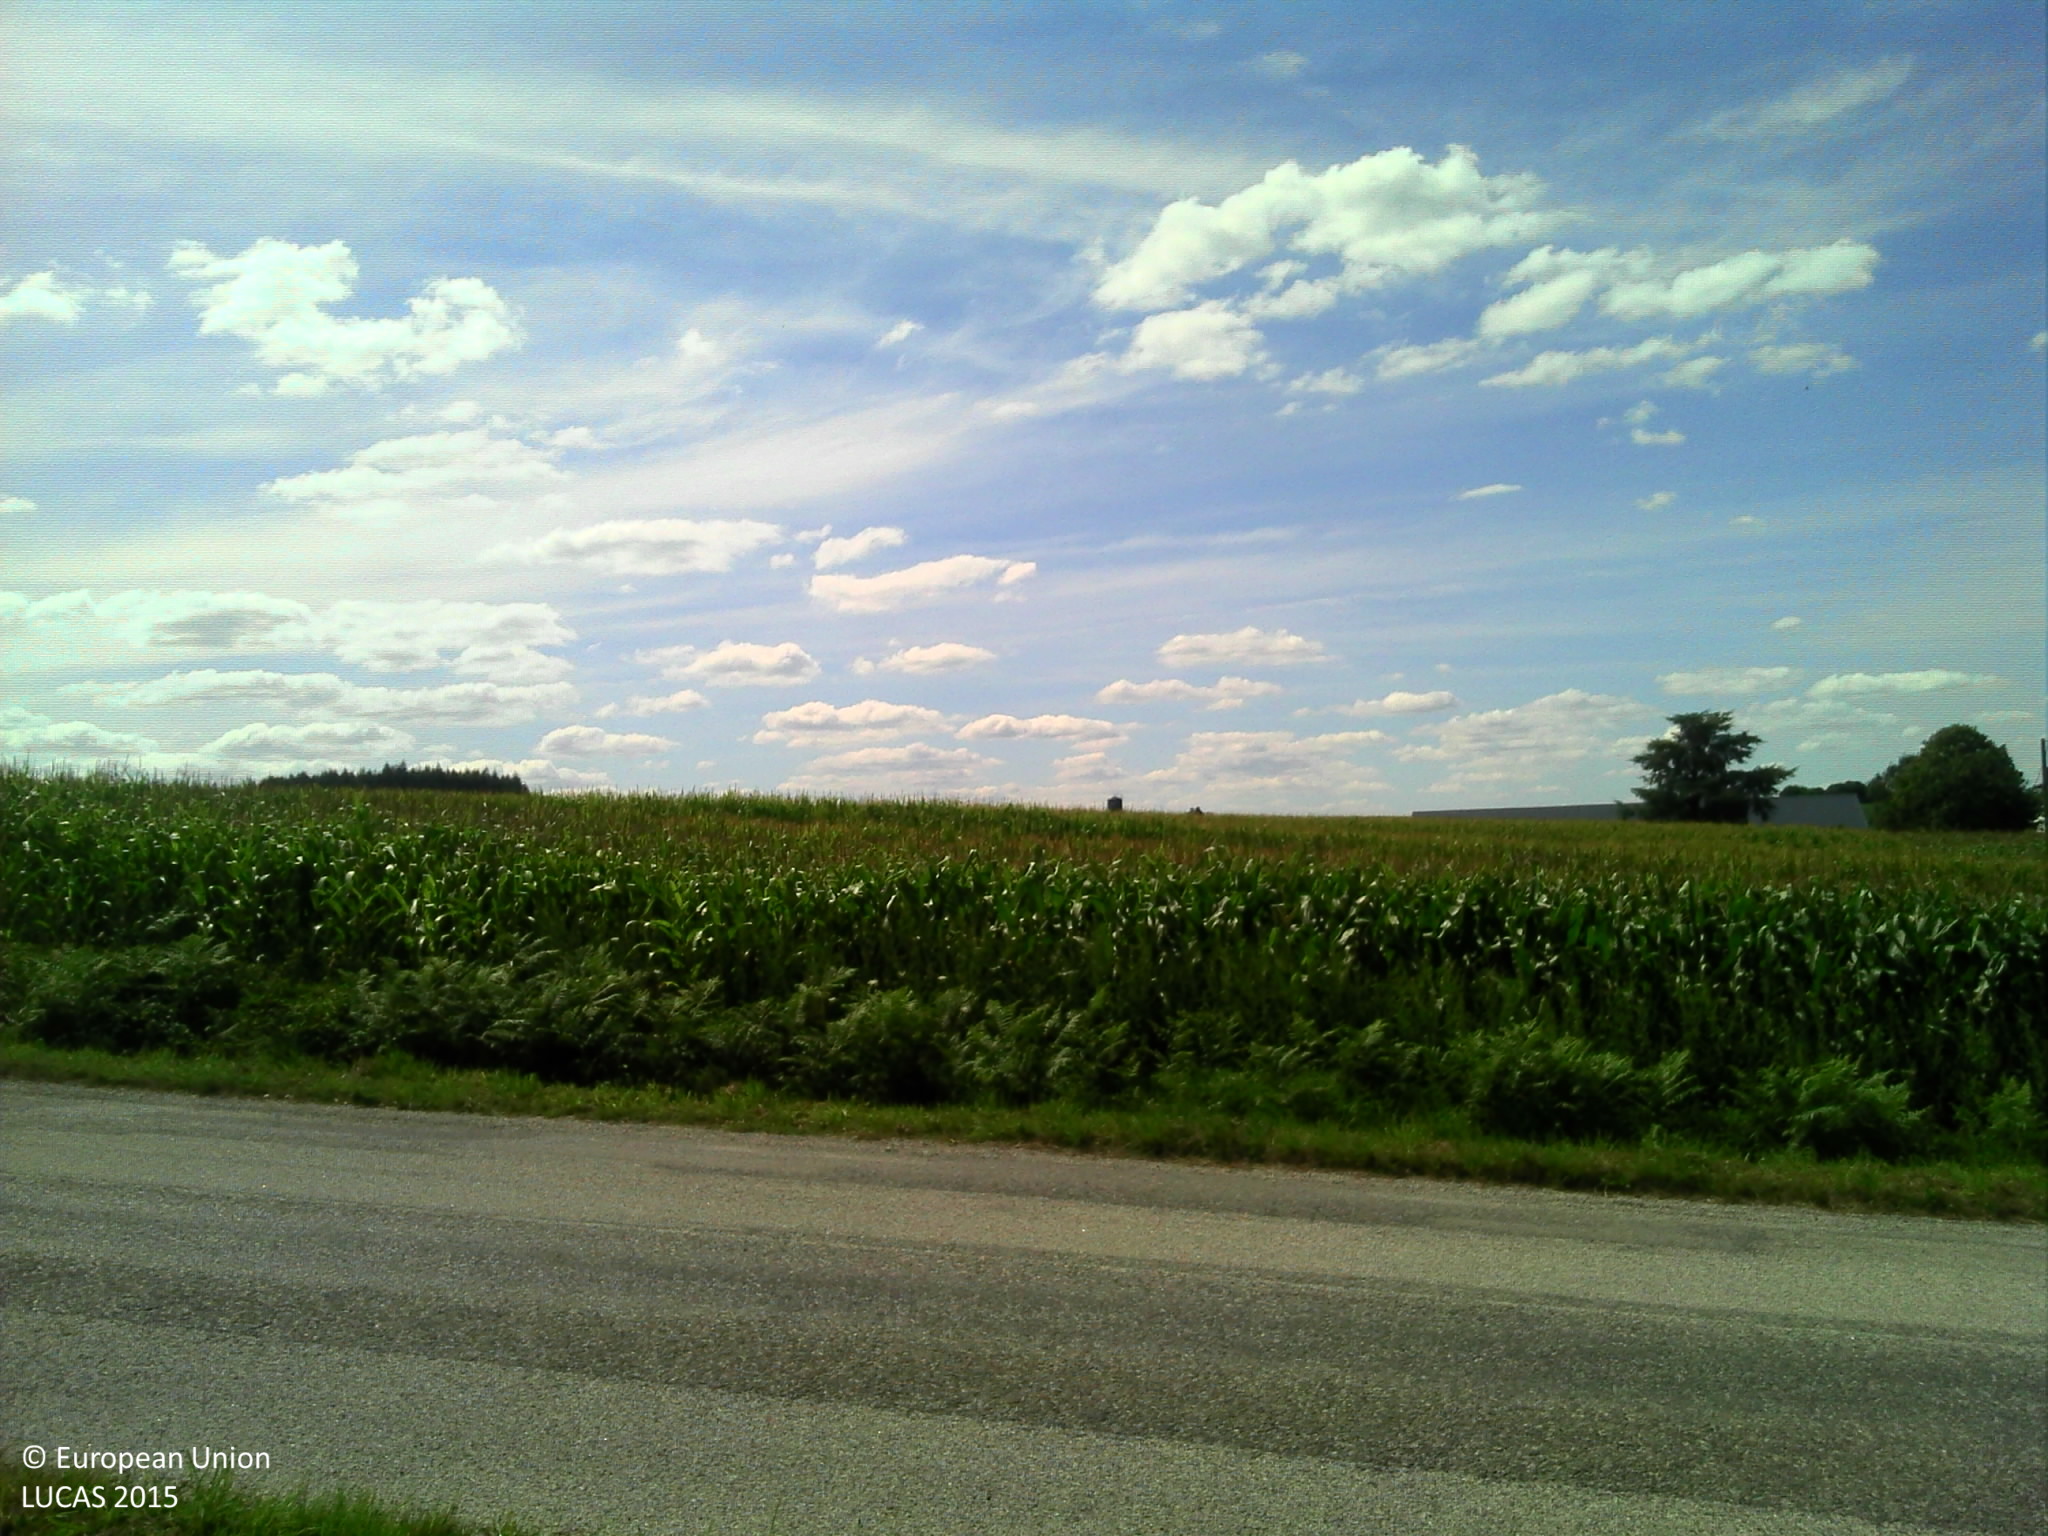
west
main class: Cropland
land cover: Maize
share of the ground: > 75 %
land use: Agriculture (excluding fallow land and kitchen gardens)
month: July
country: FR
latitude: 47.9996
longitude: -2.9739
